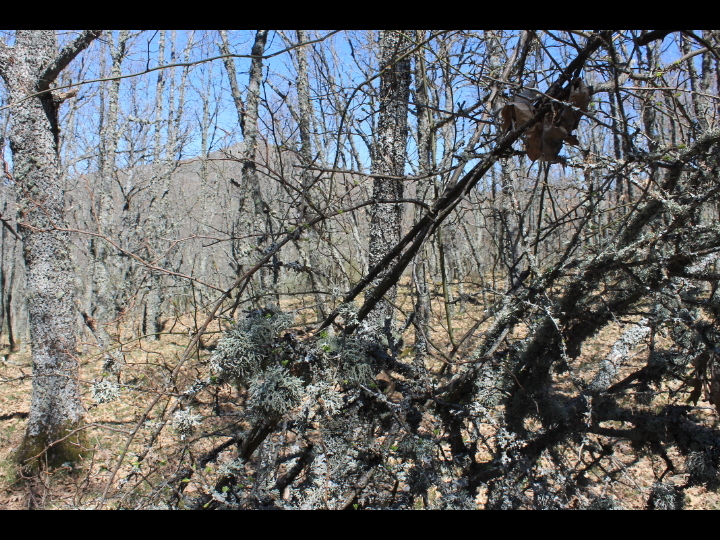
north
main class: Woodland
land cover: Broadleaved woodland
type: thermophilous deciduous forest
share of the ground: > 75 %
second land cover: Grassland without tree/shrub cover
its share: 10 - 25 %
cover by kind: broadleaved forest trees 90 %, herbaceous plants 5 %, lichens and mosses 5 %
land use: Forestry
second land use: Agriculture (excluding fallow land and kitchen gardens)
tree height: > 5 m
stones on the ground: < 10 %
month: April
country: ES
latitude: 40.9076
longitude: -3.9975
